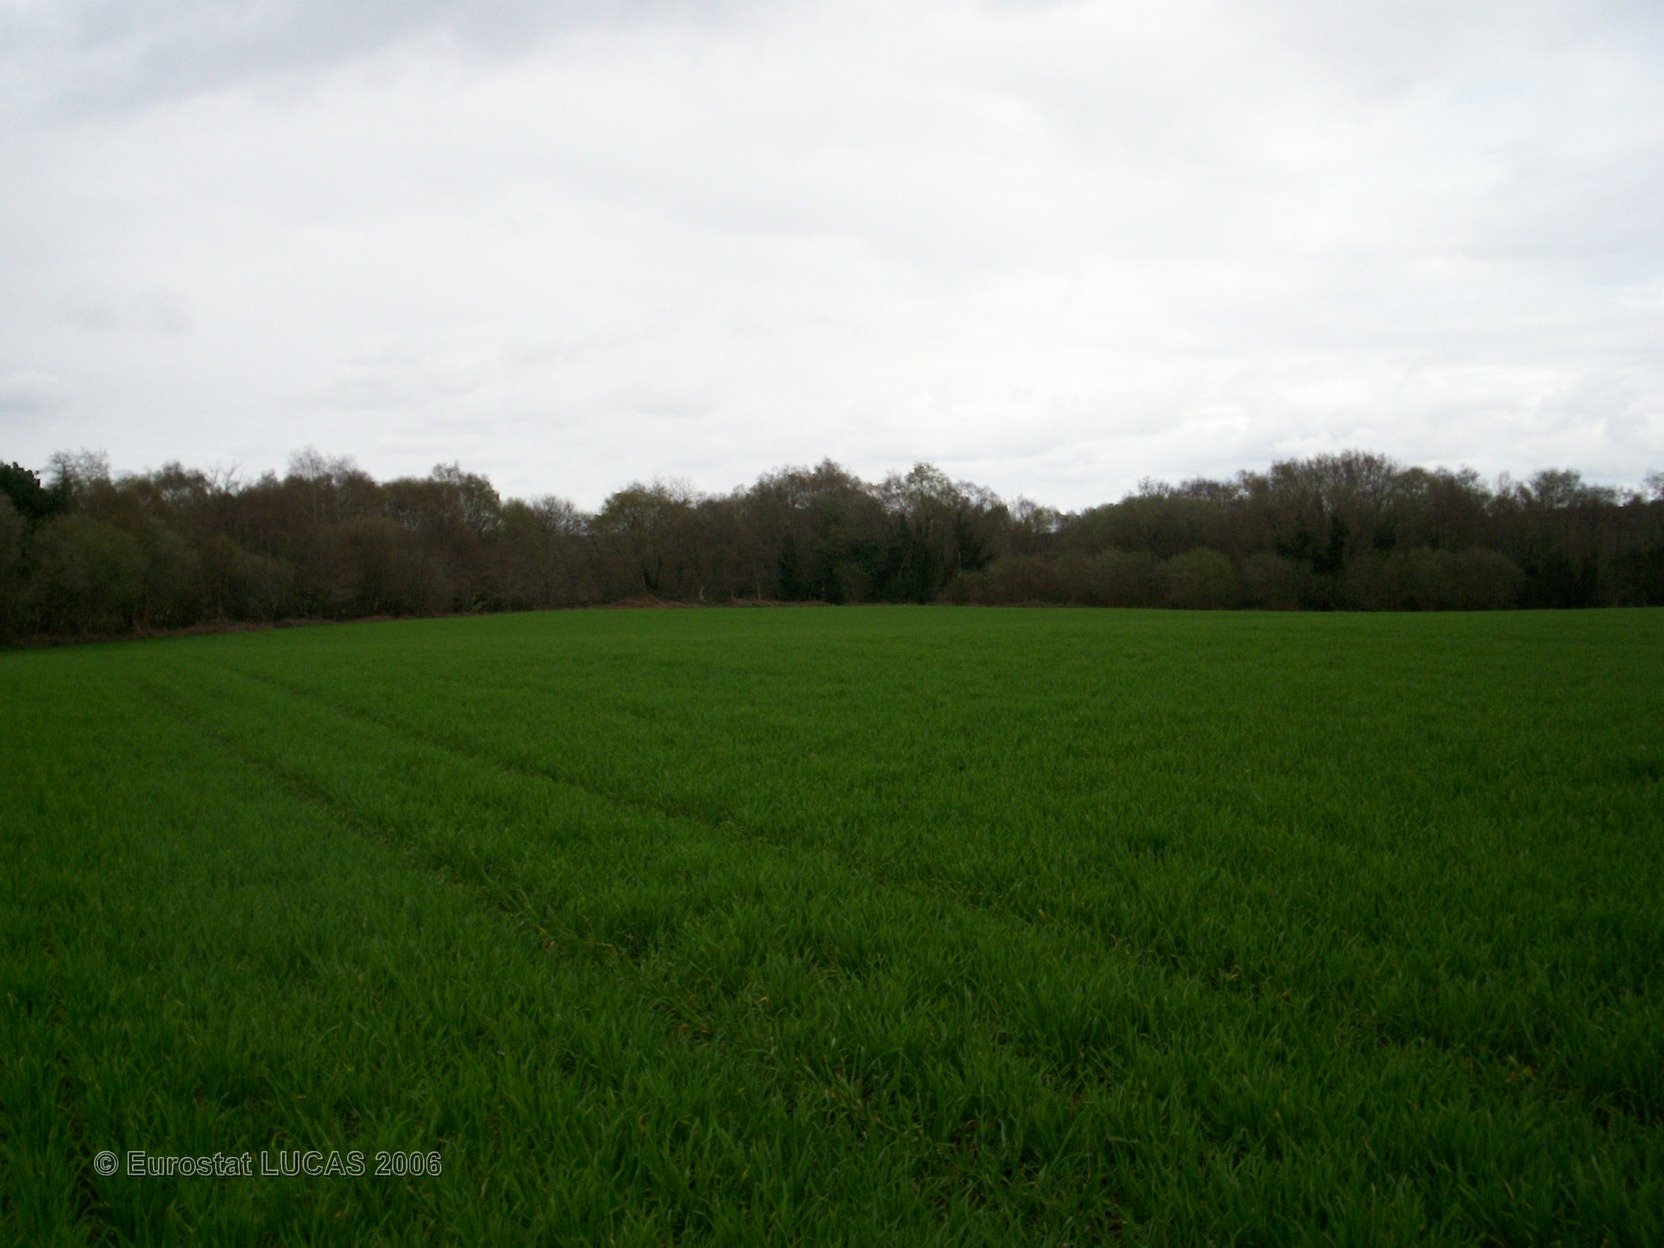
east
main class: Cropland
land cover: Common wheat
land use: Agriculture (excluding fallow land and kitchen gardens)
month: April
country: FR
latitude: 47.8295
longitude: -3.4740
